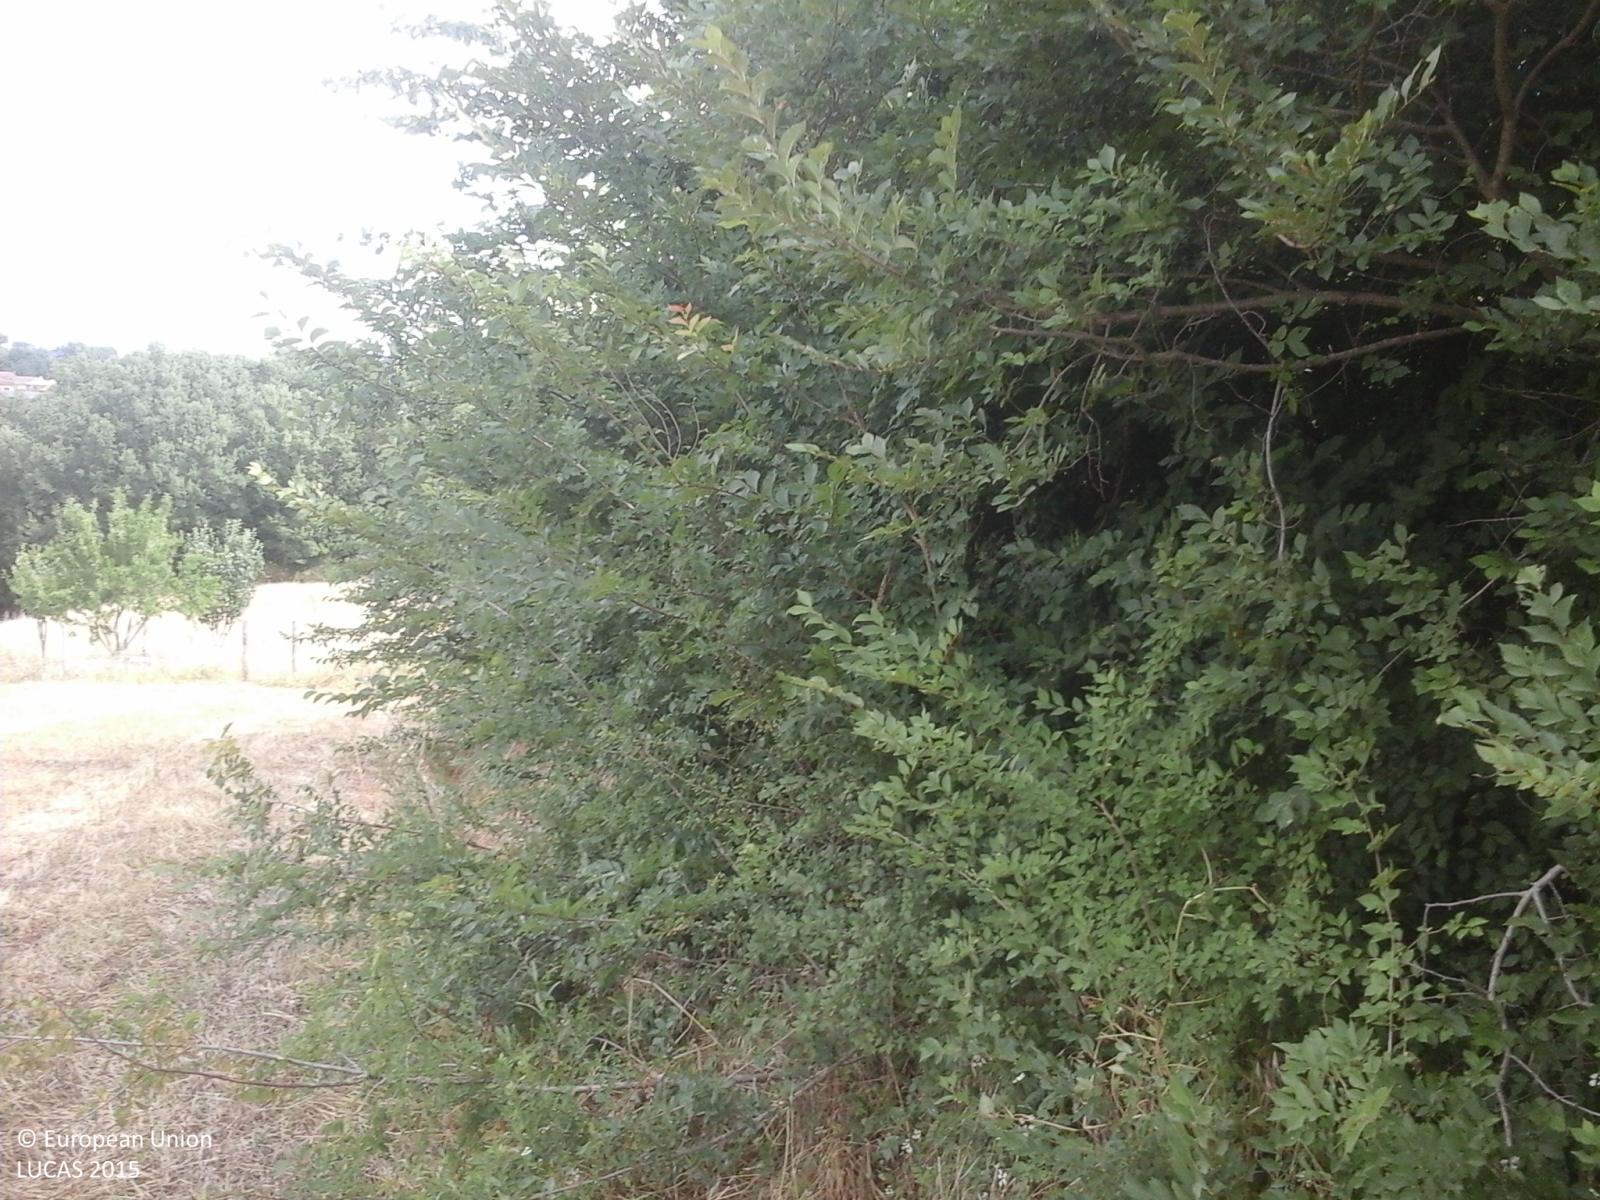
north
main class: Woodland
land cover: Broadleaved woodland
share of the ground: > 75 %
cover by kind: broadleaved forest trees 90 %, shrubs 10 %
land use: Abandoned areas
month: June
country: IT
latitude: 41.0213
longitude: 15.1300
